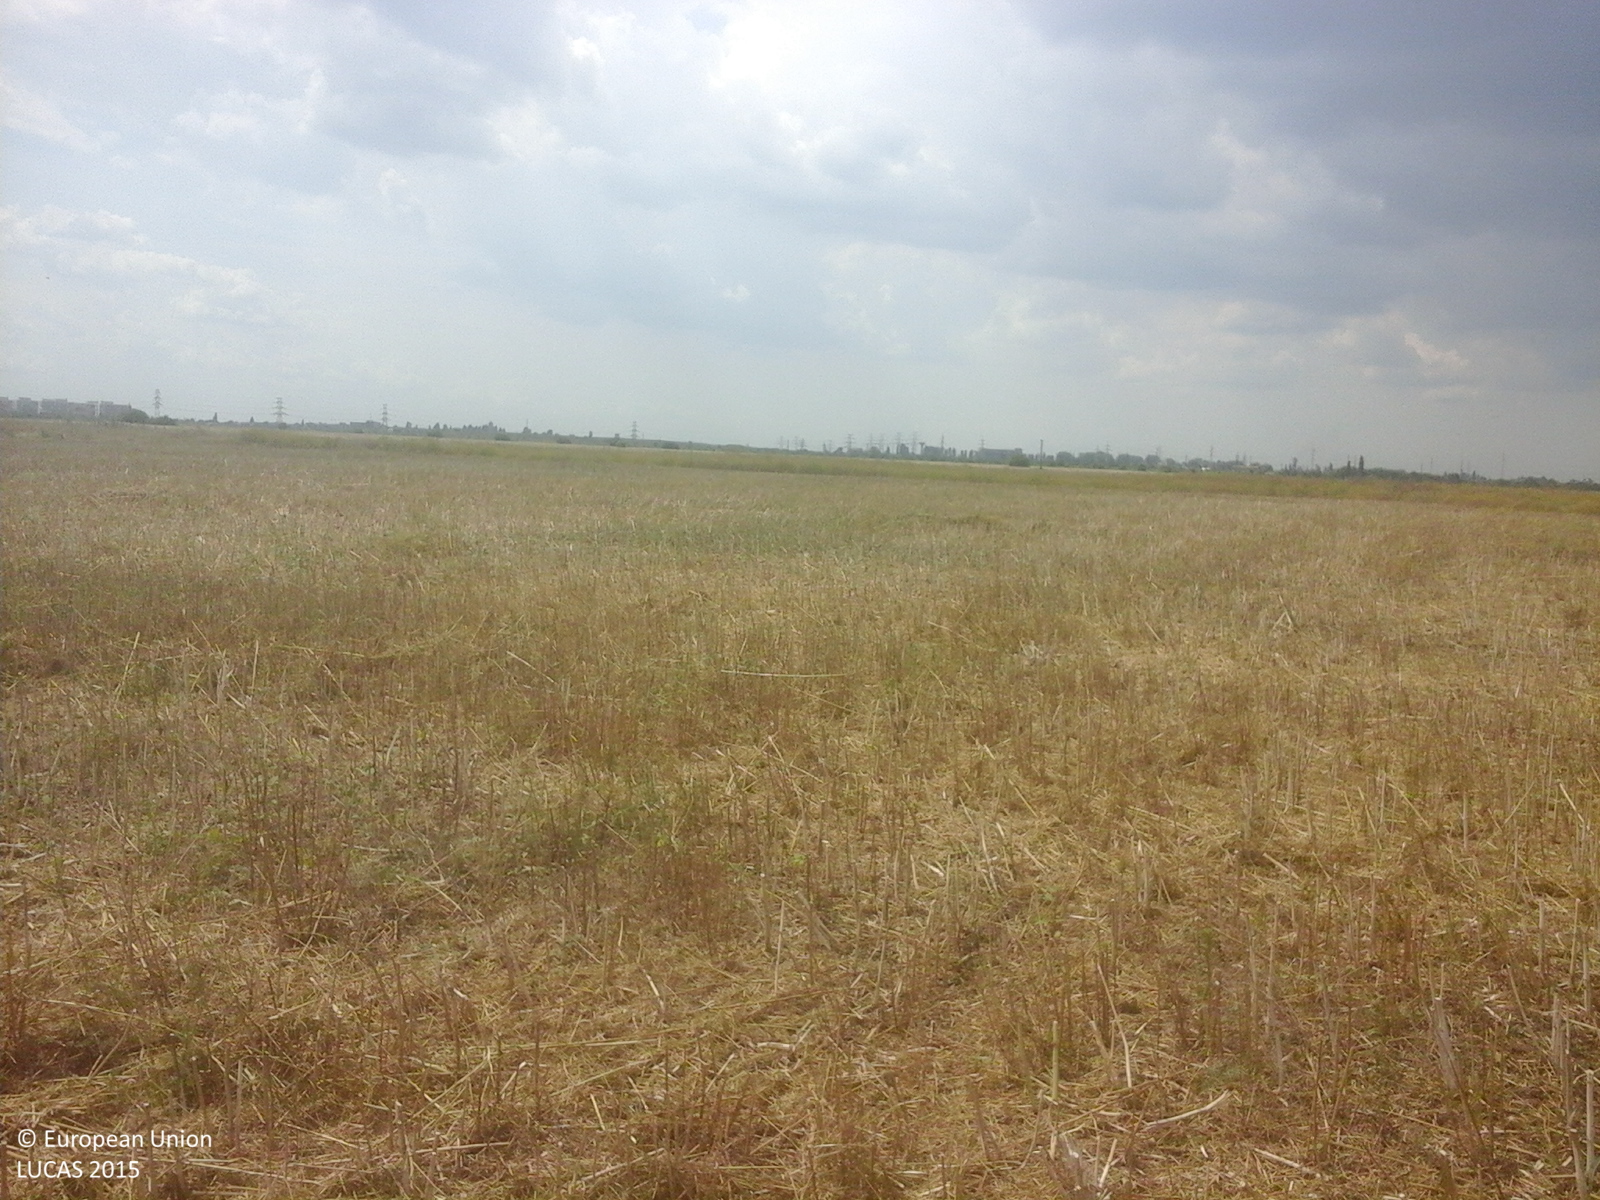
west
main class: Cropland
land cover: Other leguminous and mixtures for fodder
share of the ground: > 75 %
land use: Agriculture (excluding fallow land and kitchen gardens)
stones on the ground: < 10 %
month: June
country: RO
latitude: 44.3467
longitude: 26.1236
